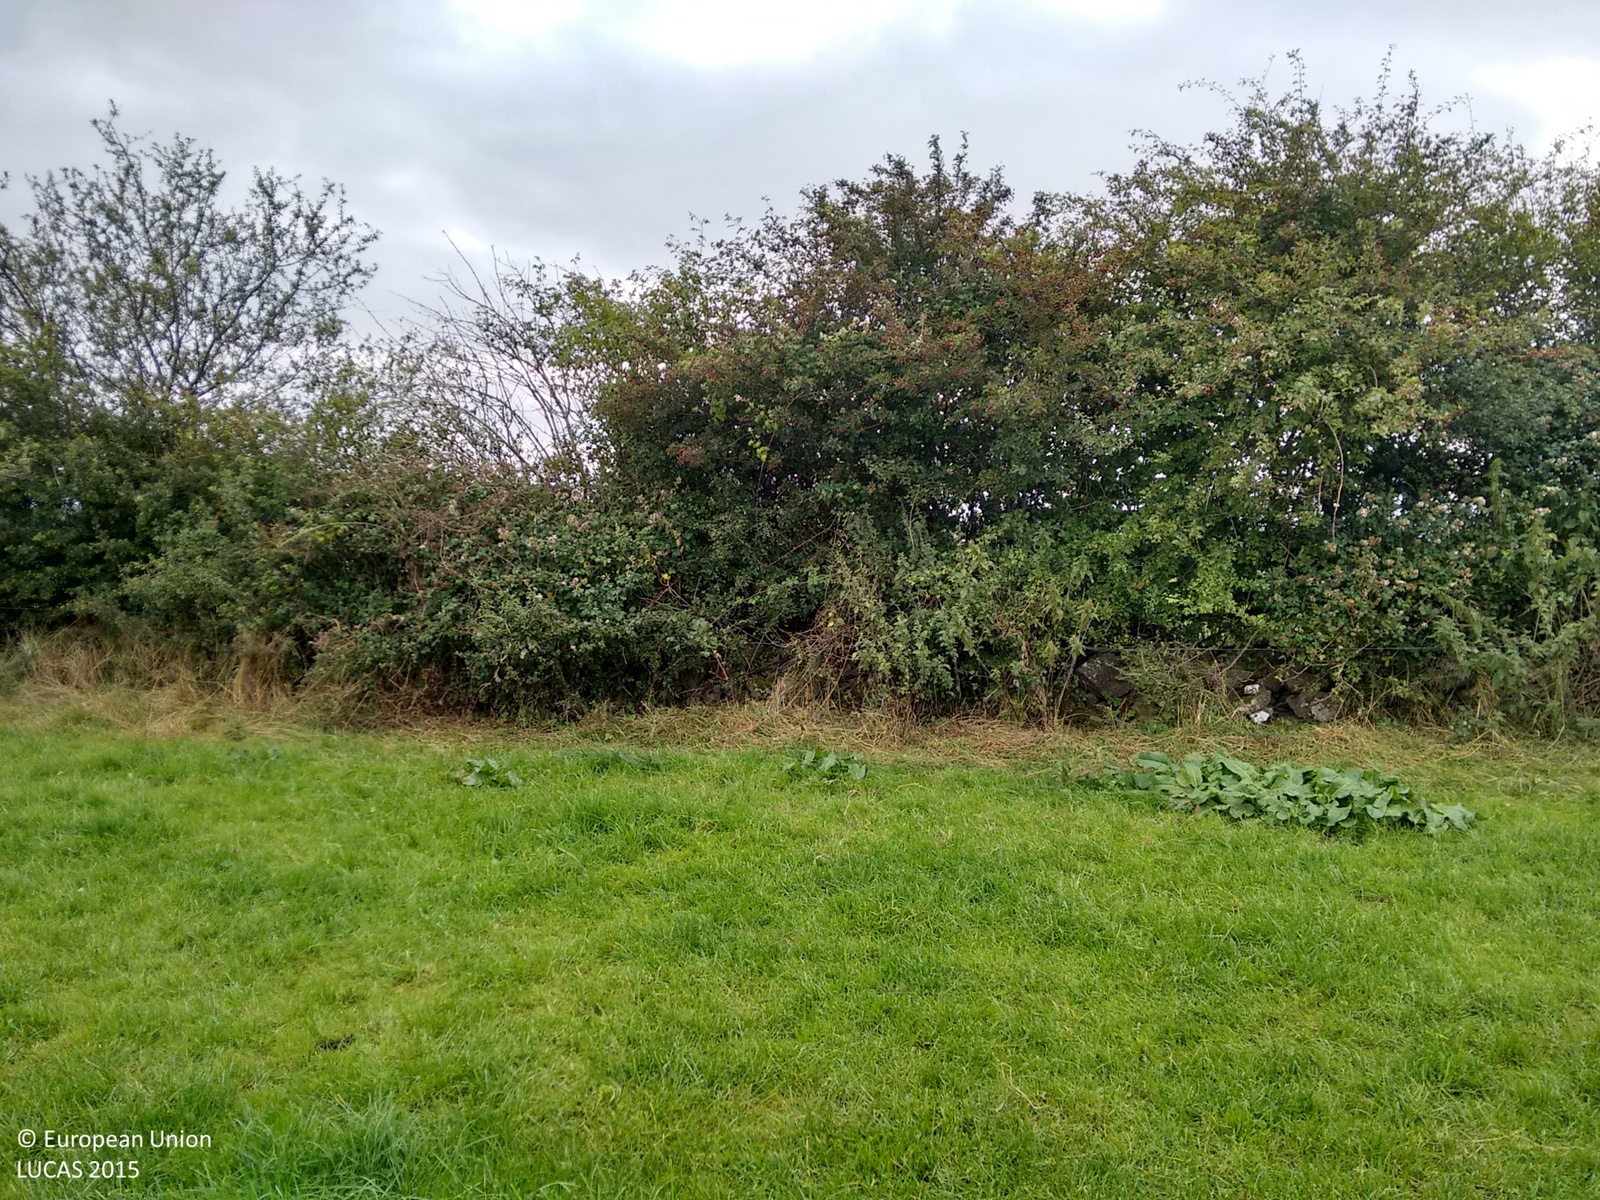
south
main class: Grassland
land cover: Grassland without tree/shrub cover
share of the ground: > 75 %
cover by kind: herbaceous plants 100 %
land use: Agriculture (excluding fallow land and kitchen gardens)
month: September
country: IE
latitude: 52.5232
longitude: -9.0049
